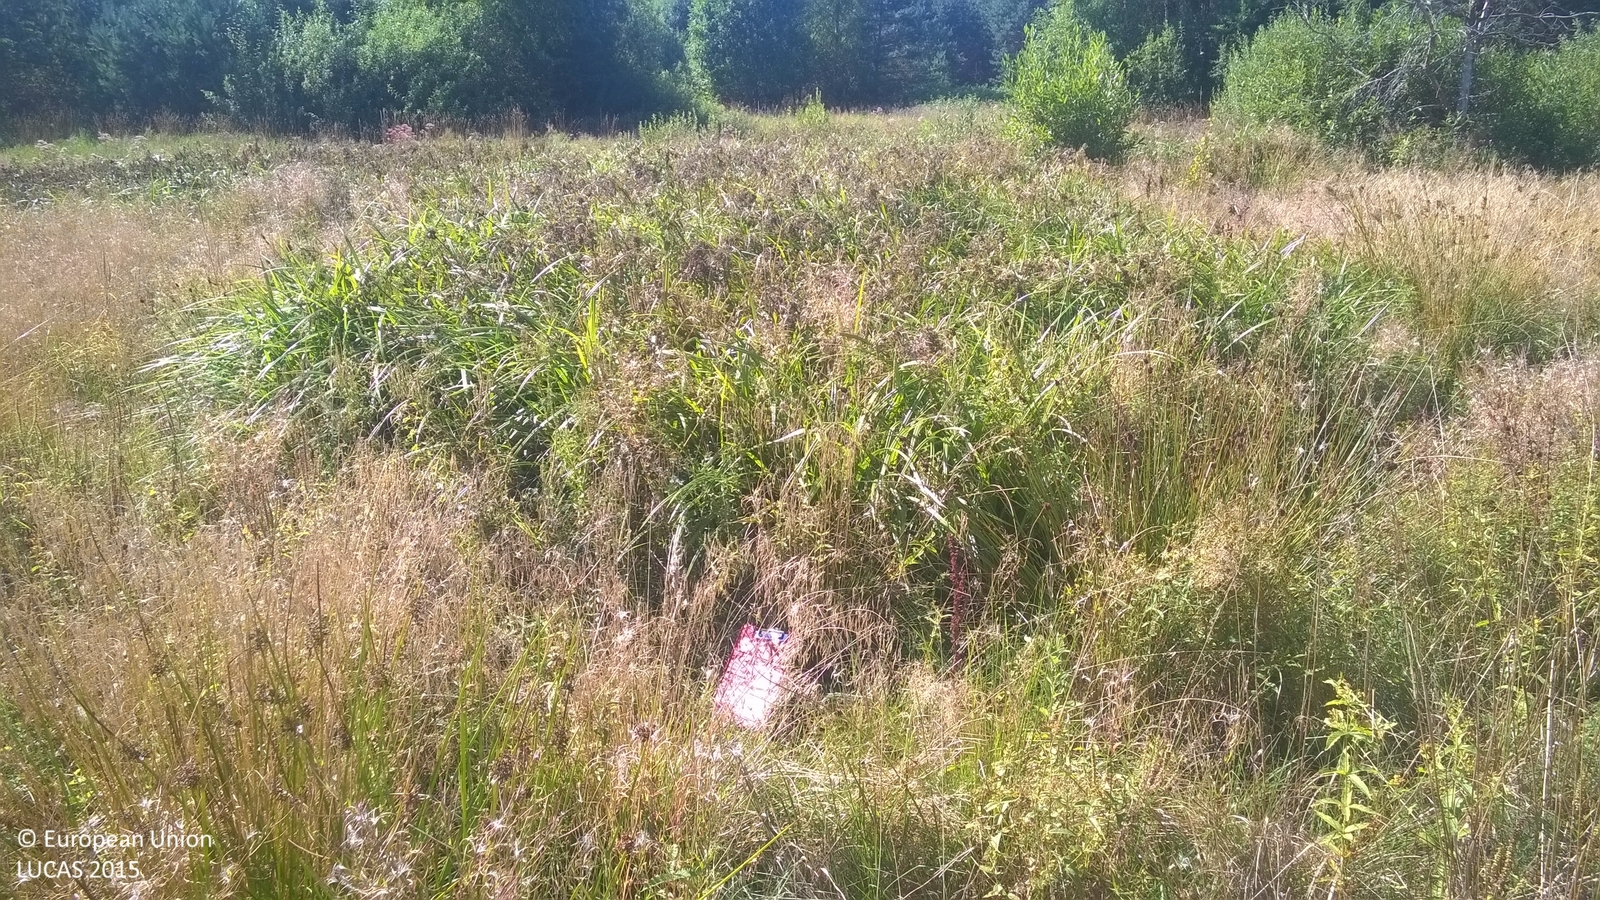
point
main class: Grassland
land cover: Spontaneously vegetated surfaces
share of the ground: > 75 %
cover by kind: herbaceous plants 95 %, shrubs 5 %
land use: Semi-natural and natural areas not in use
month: August
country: LV
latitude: 57.7141
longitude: 26.1273
